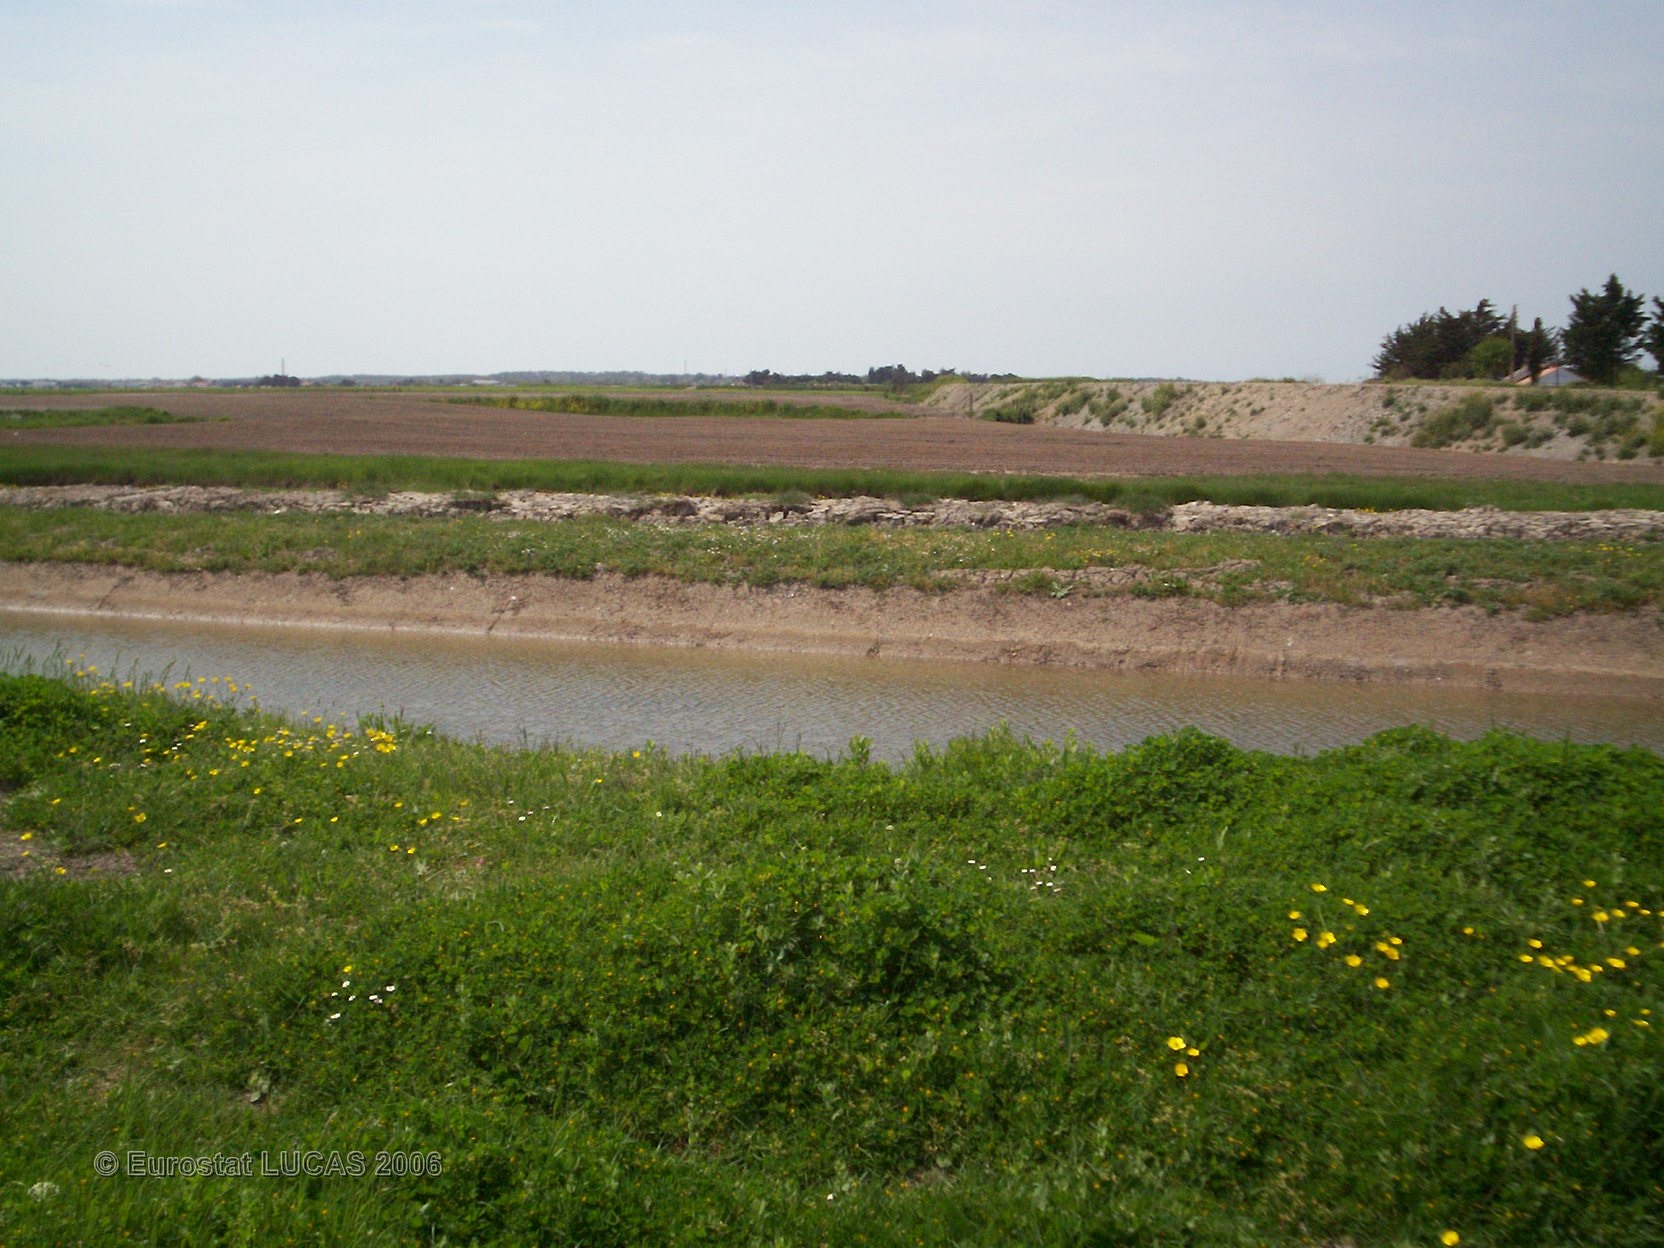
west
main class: Grassland
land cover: Grassland without tree/shrub cover
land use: Agriculture (excluding fallow land and kitchen gardens)
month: May
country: FR
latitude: 46.9008
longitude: -2.0851
